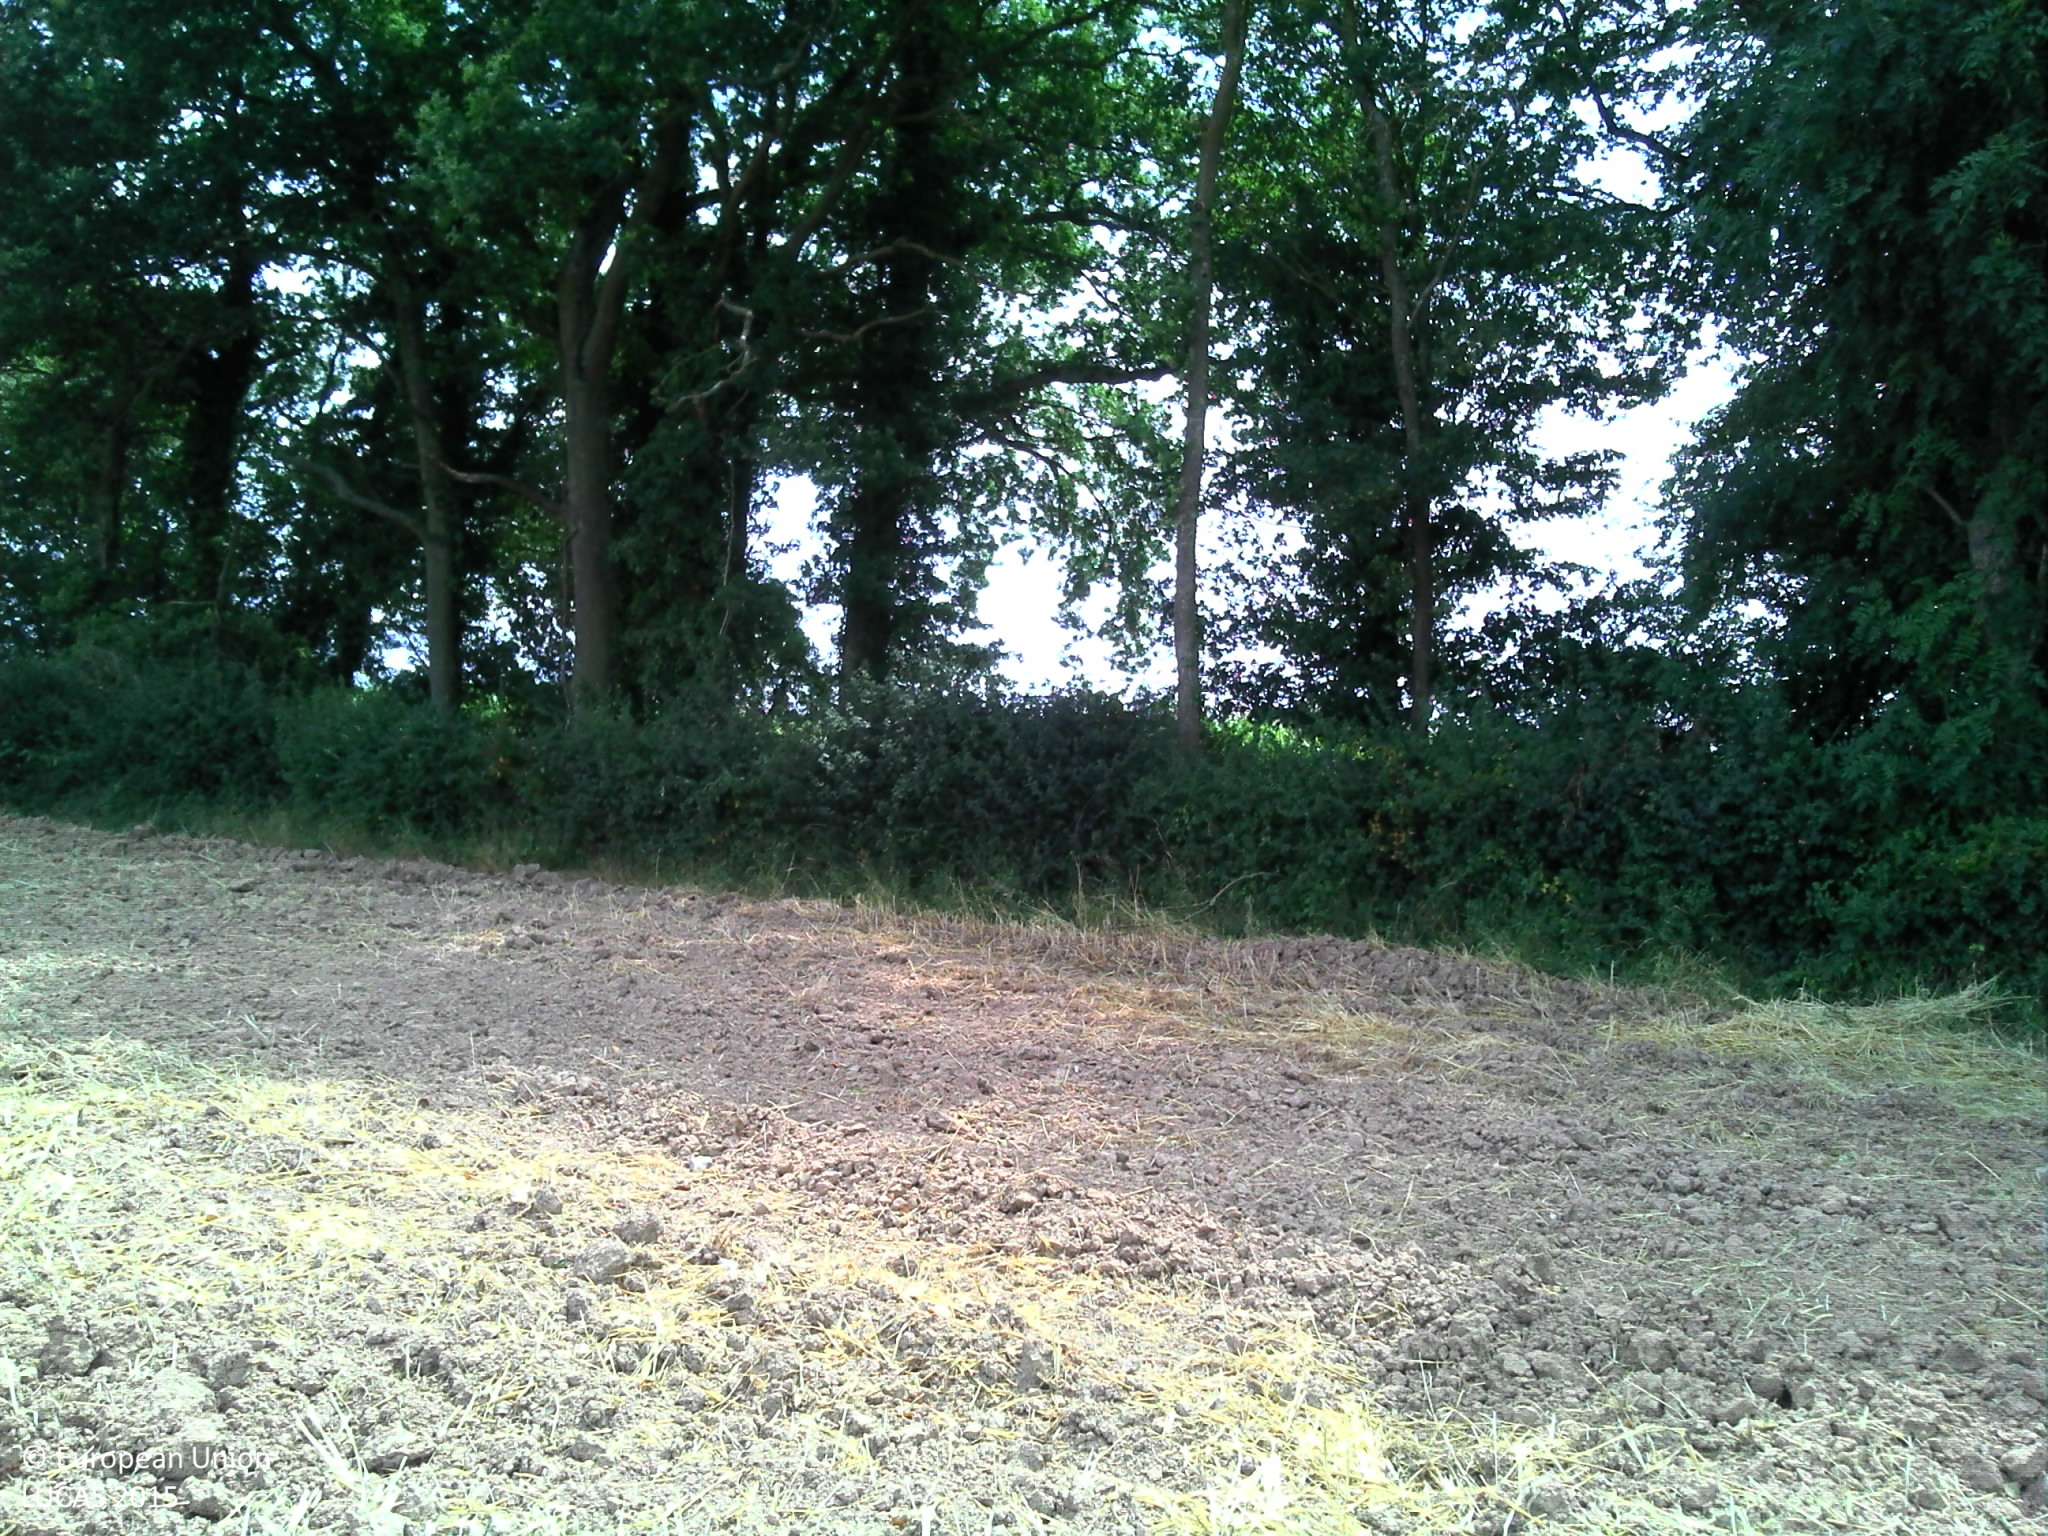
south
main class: Cropland
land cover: Barley
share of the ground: > 75 %
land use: Agriculture (excluding fallow land and kitchen gardens)
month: July
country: FR
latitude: 46.6071
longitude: 2.9595
